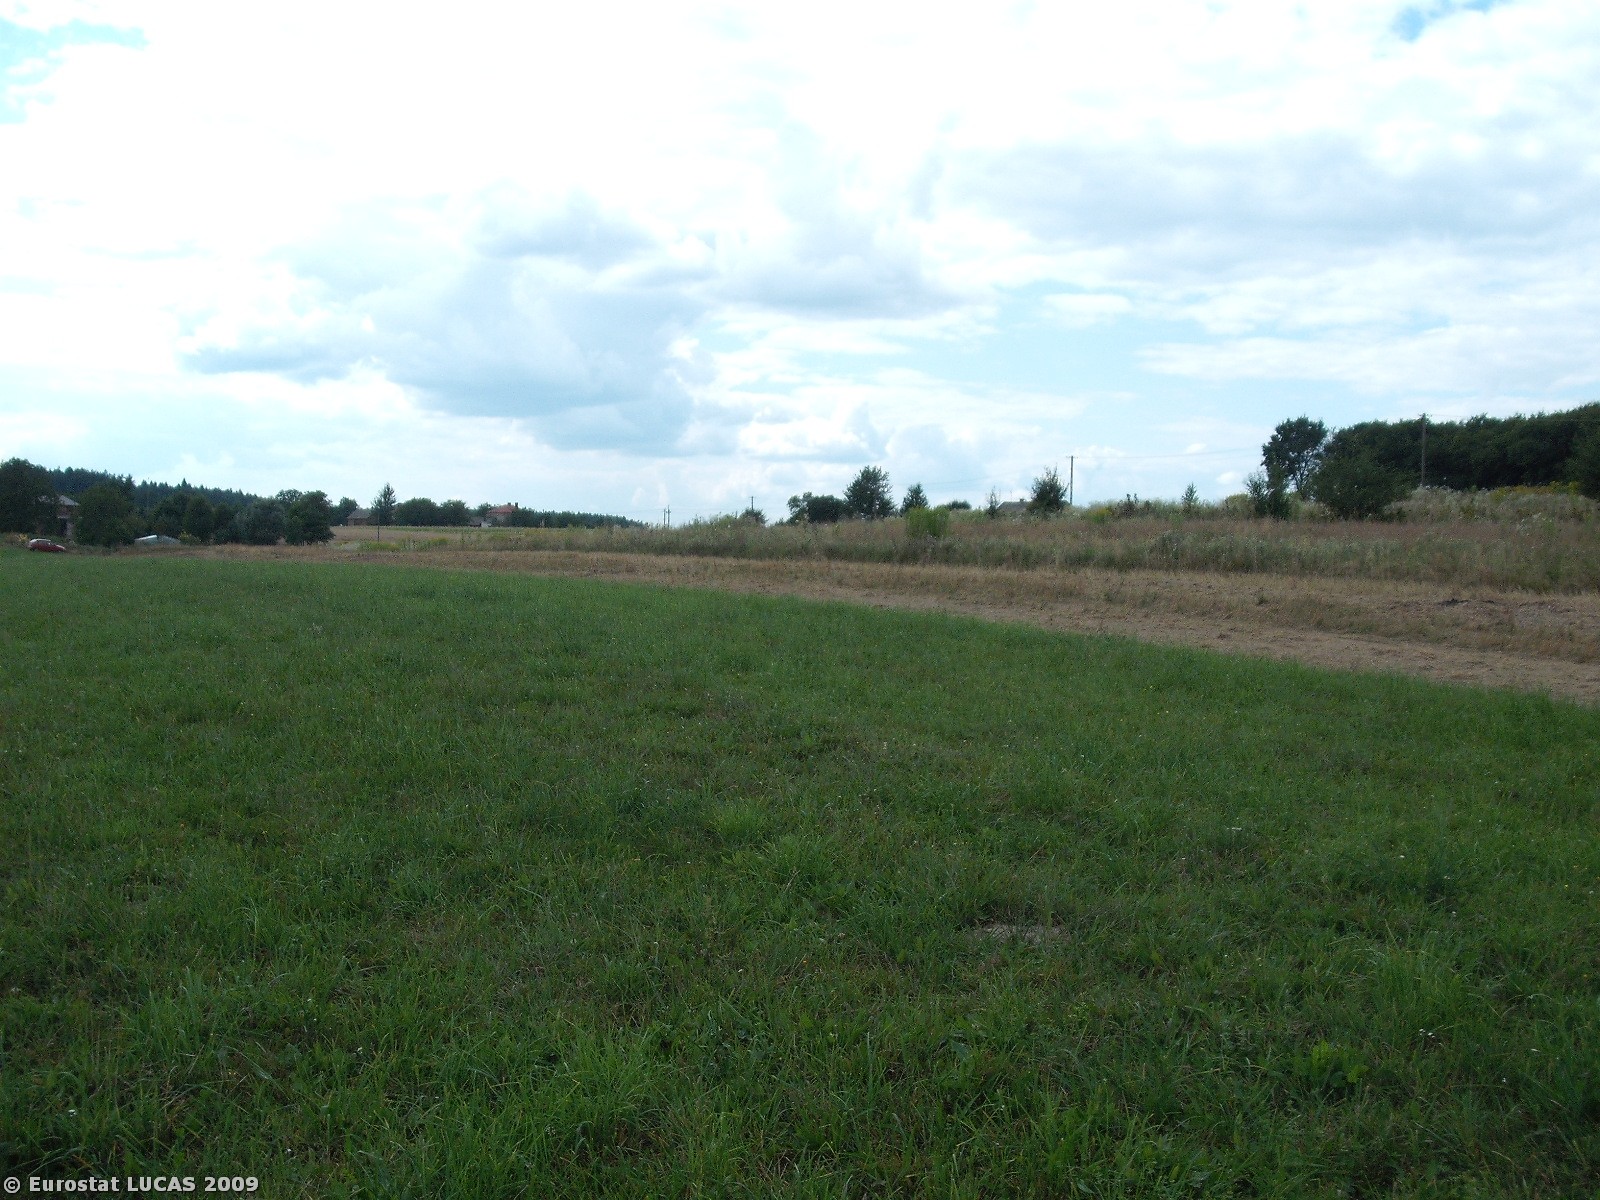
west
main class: Grassland
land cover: Grassland without tree/shrub cover
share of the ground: > 75 %
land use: Agriculture (excluding fallow land and kitchen gardens)
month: August
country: PL
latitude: 50.1774
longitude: 22.4004
